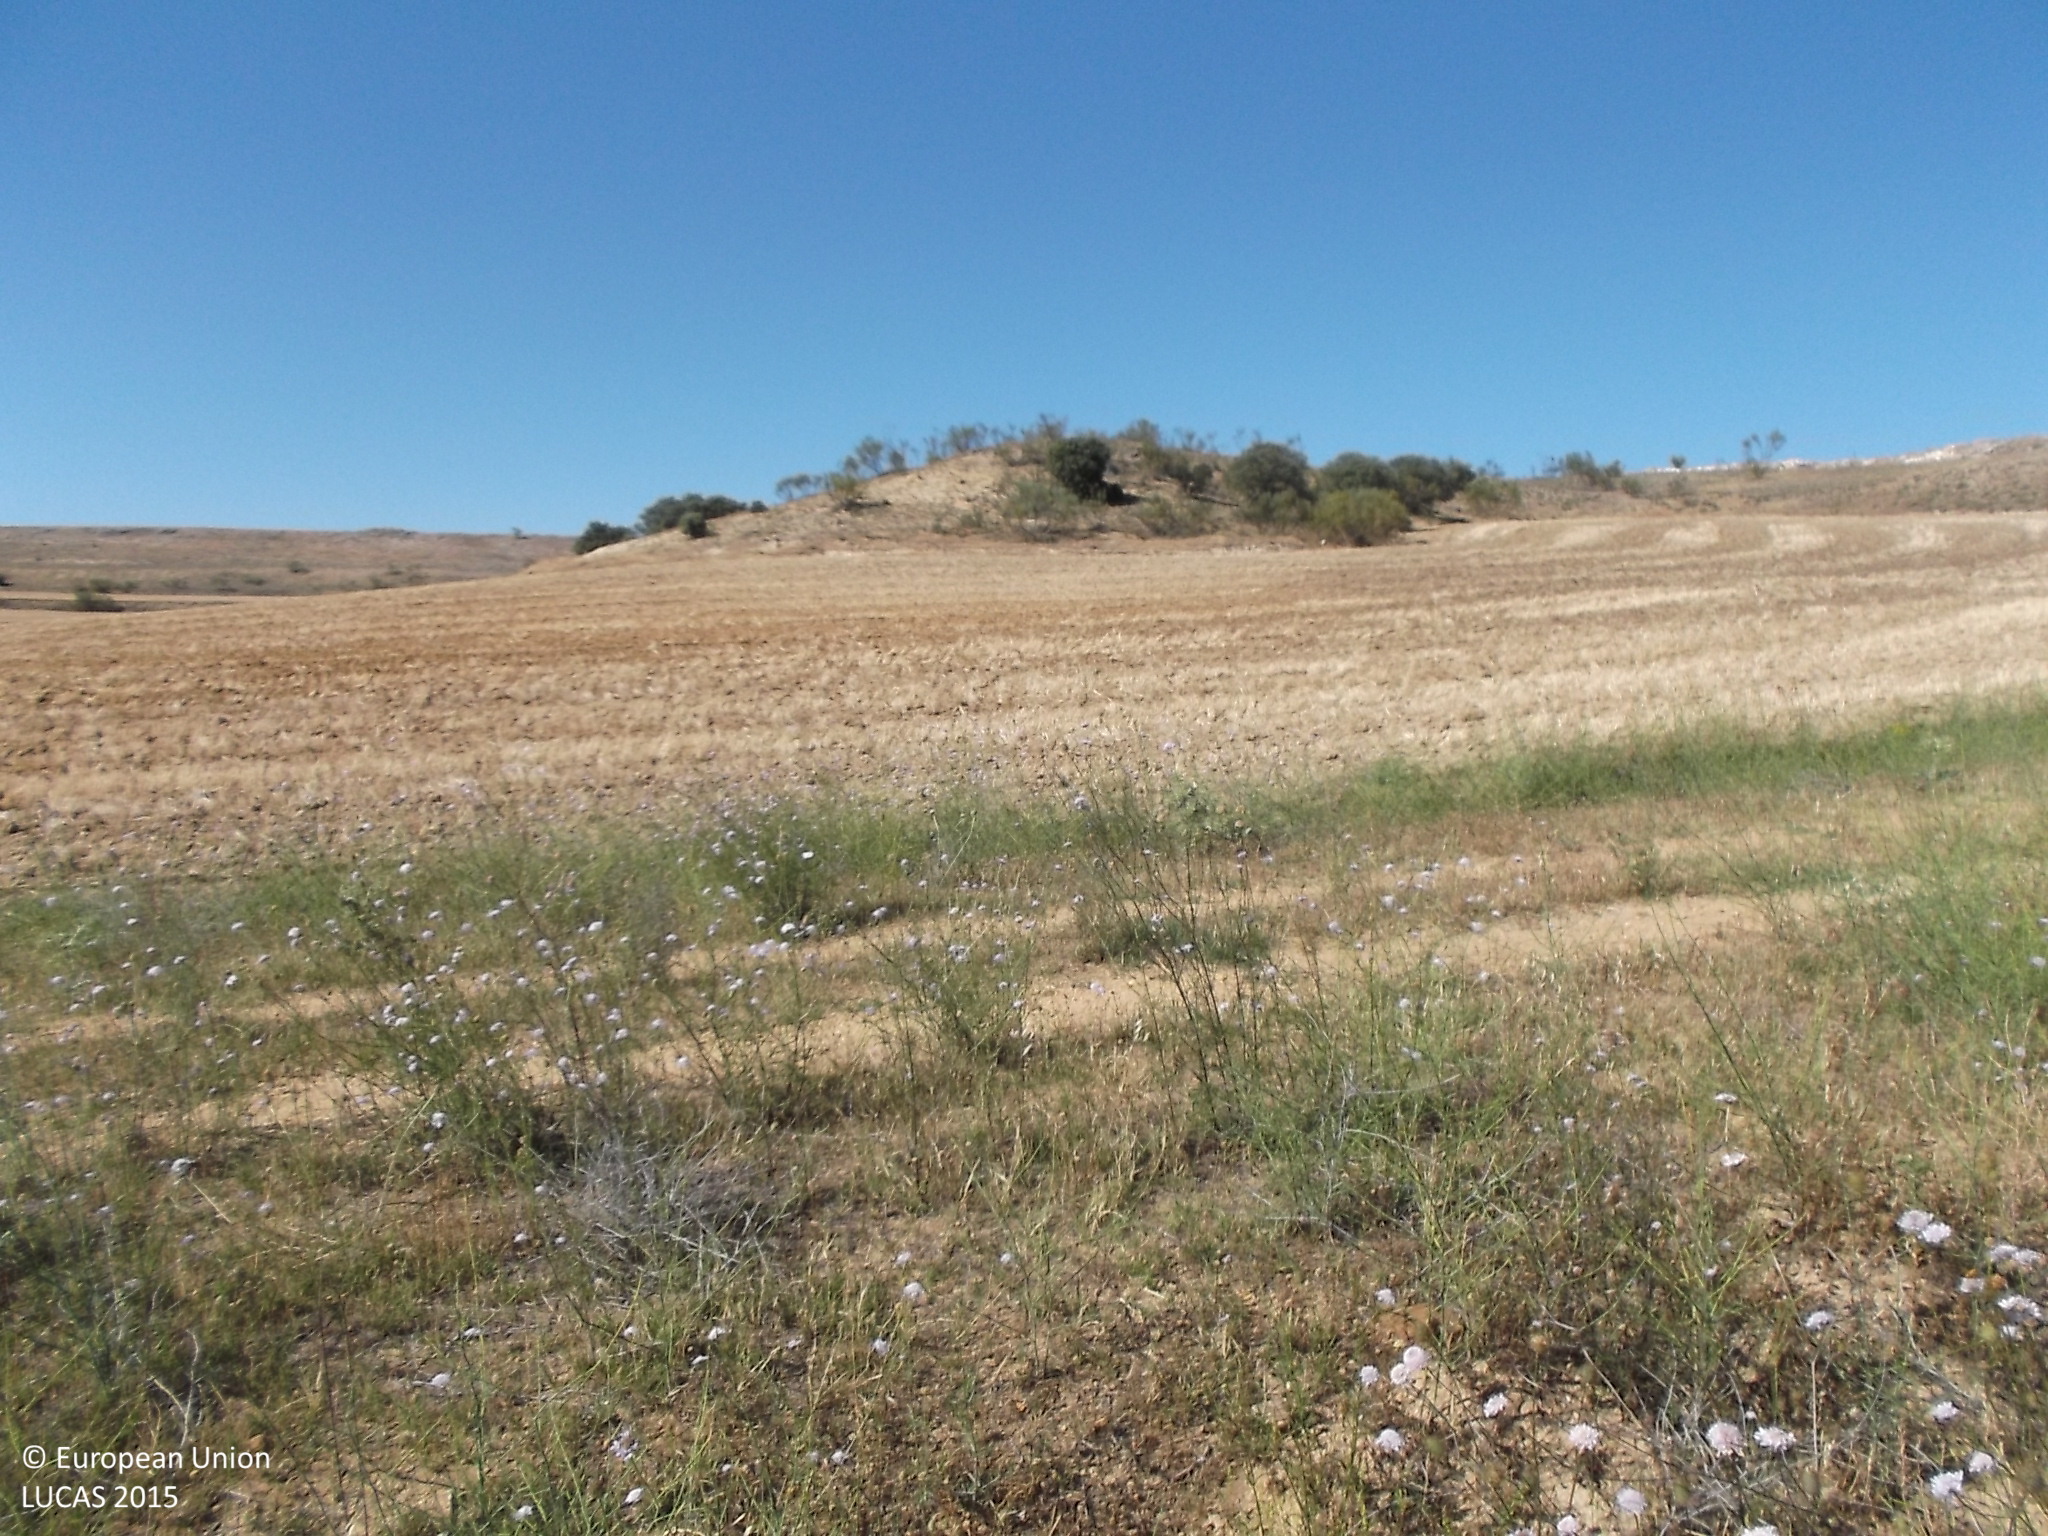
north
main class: Cropland
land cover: Barley
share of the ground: > 75 %
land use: Agriculture (excluding fallow land and kitchen gardens)
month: June
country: ES
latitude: 41.3315
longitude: -5.3343
